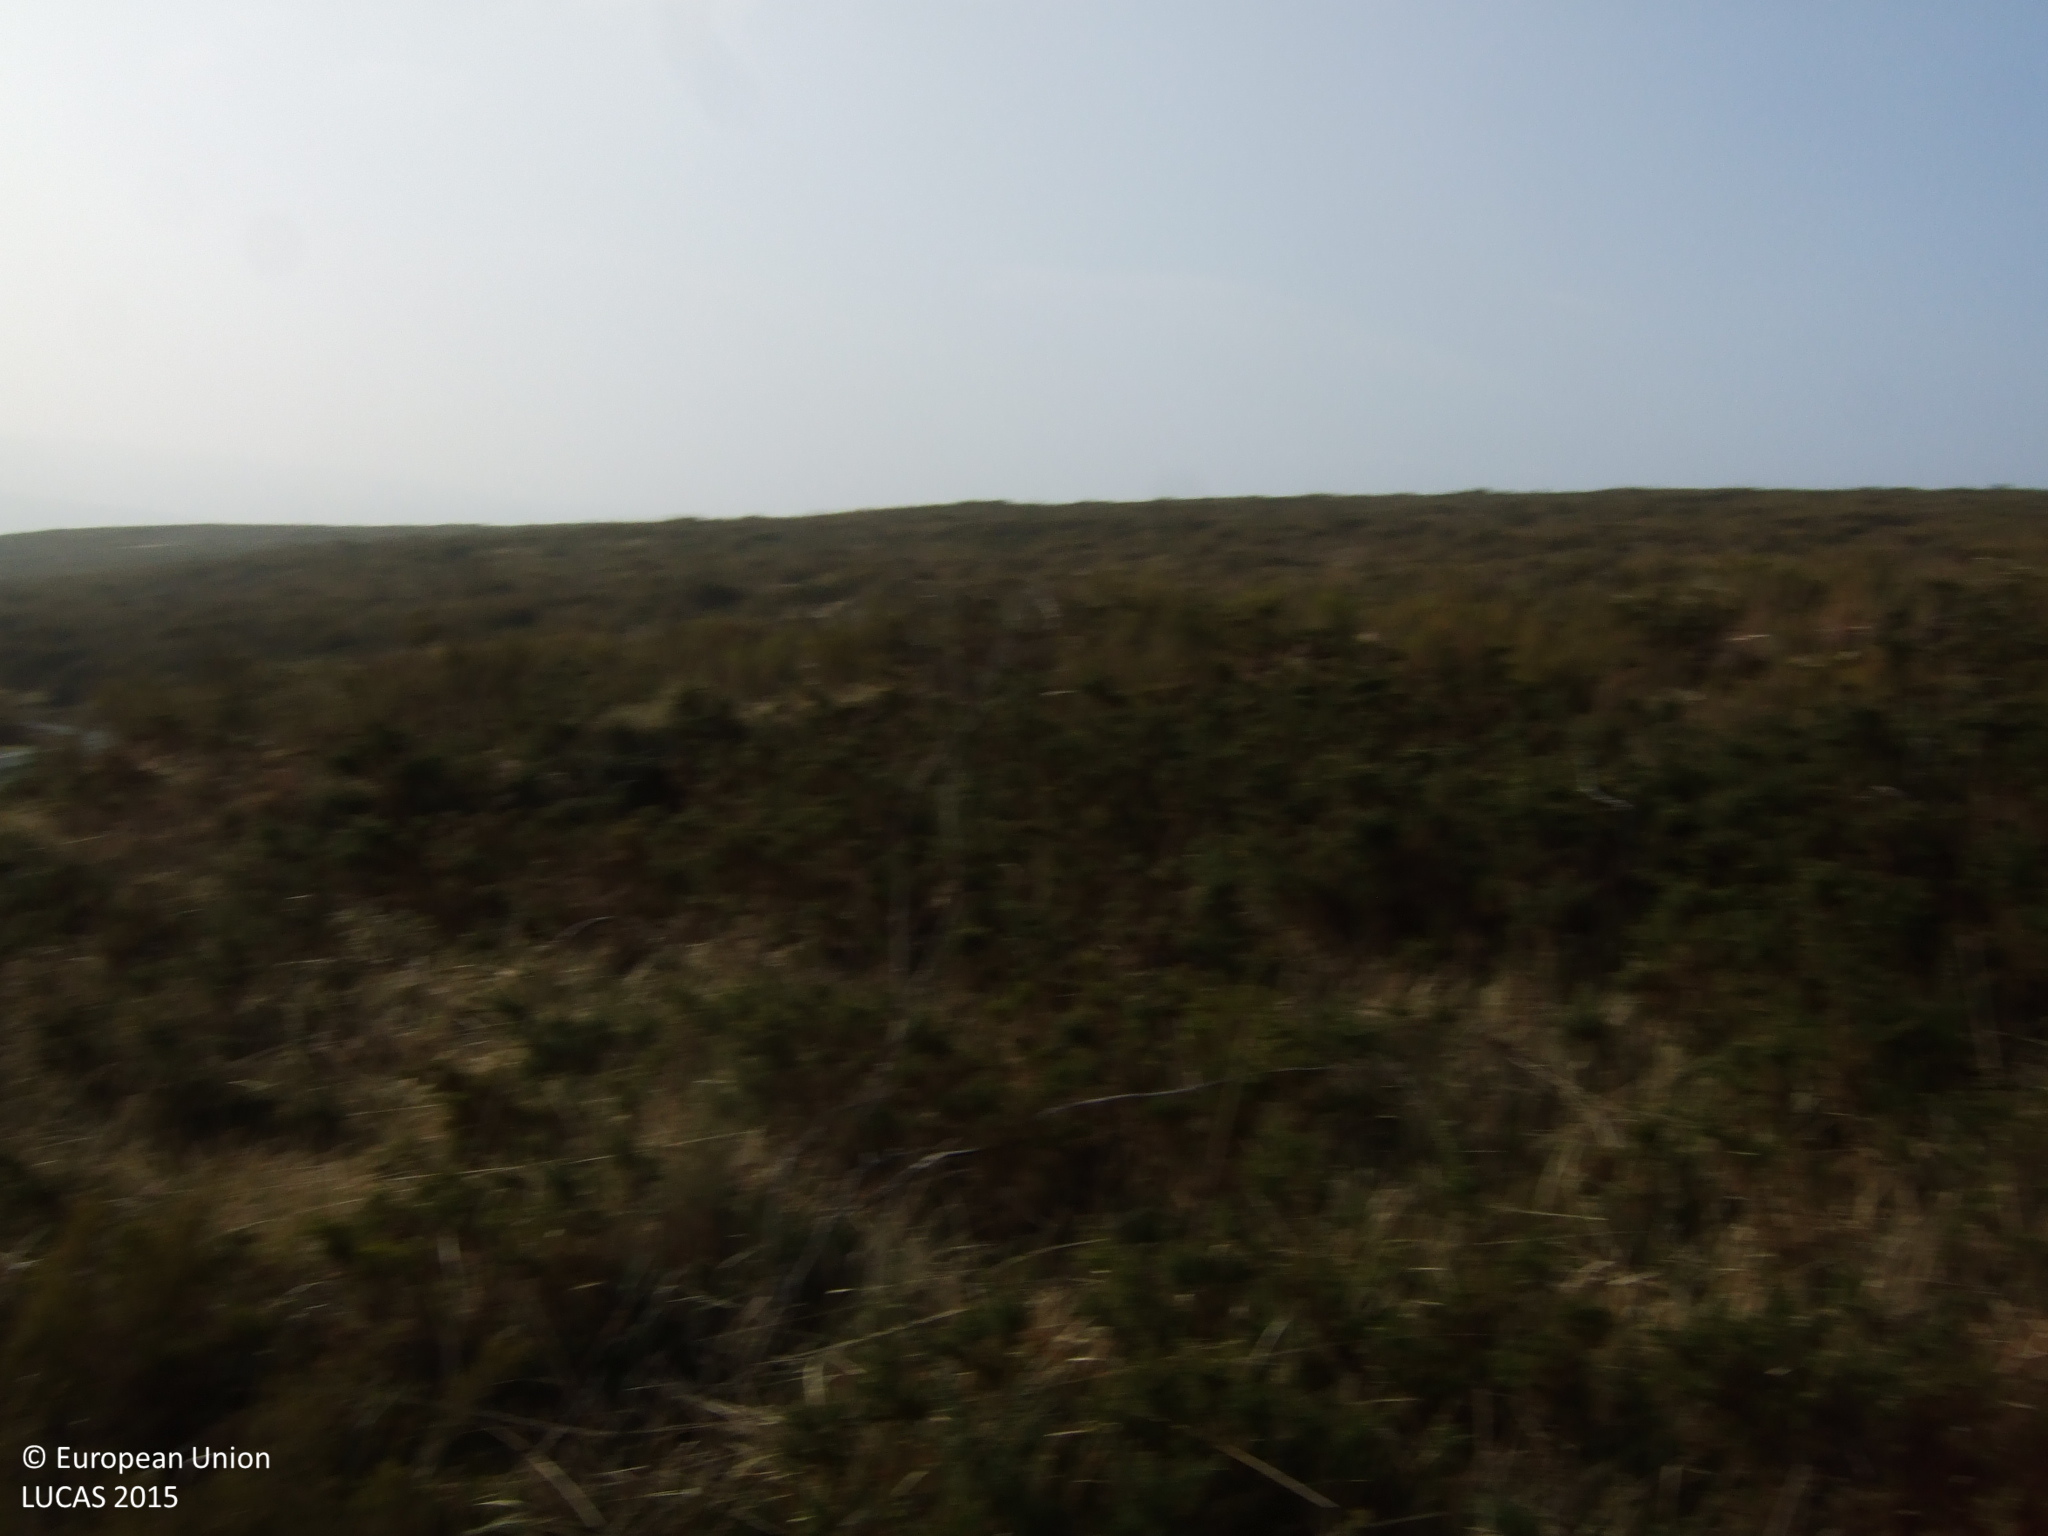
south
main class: Shrubland
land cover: Shrubland without tree cover
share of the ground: > 75 %
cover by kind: shrubs 100 %
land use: Semi-natural and natural areas not in use
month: March
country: ES
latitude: 42.9020
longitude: -7.9308
